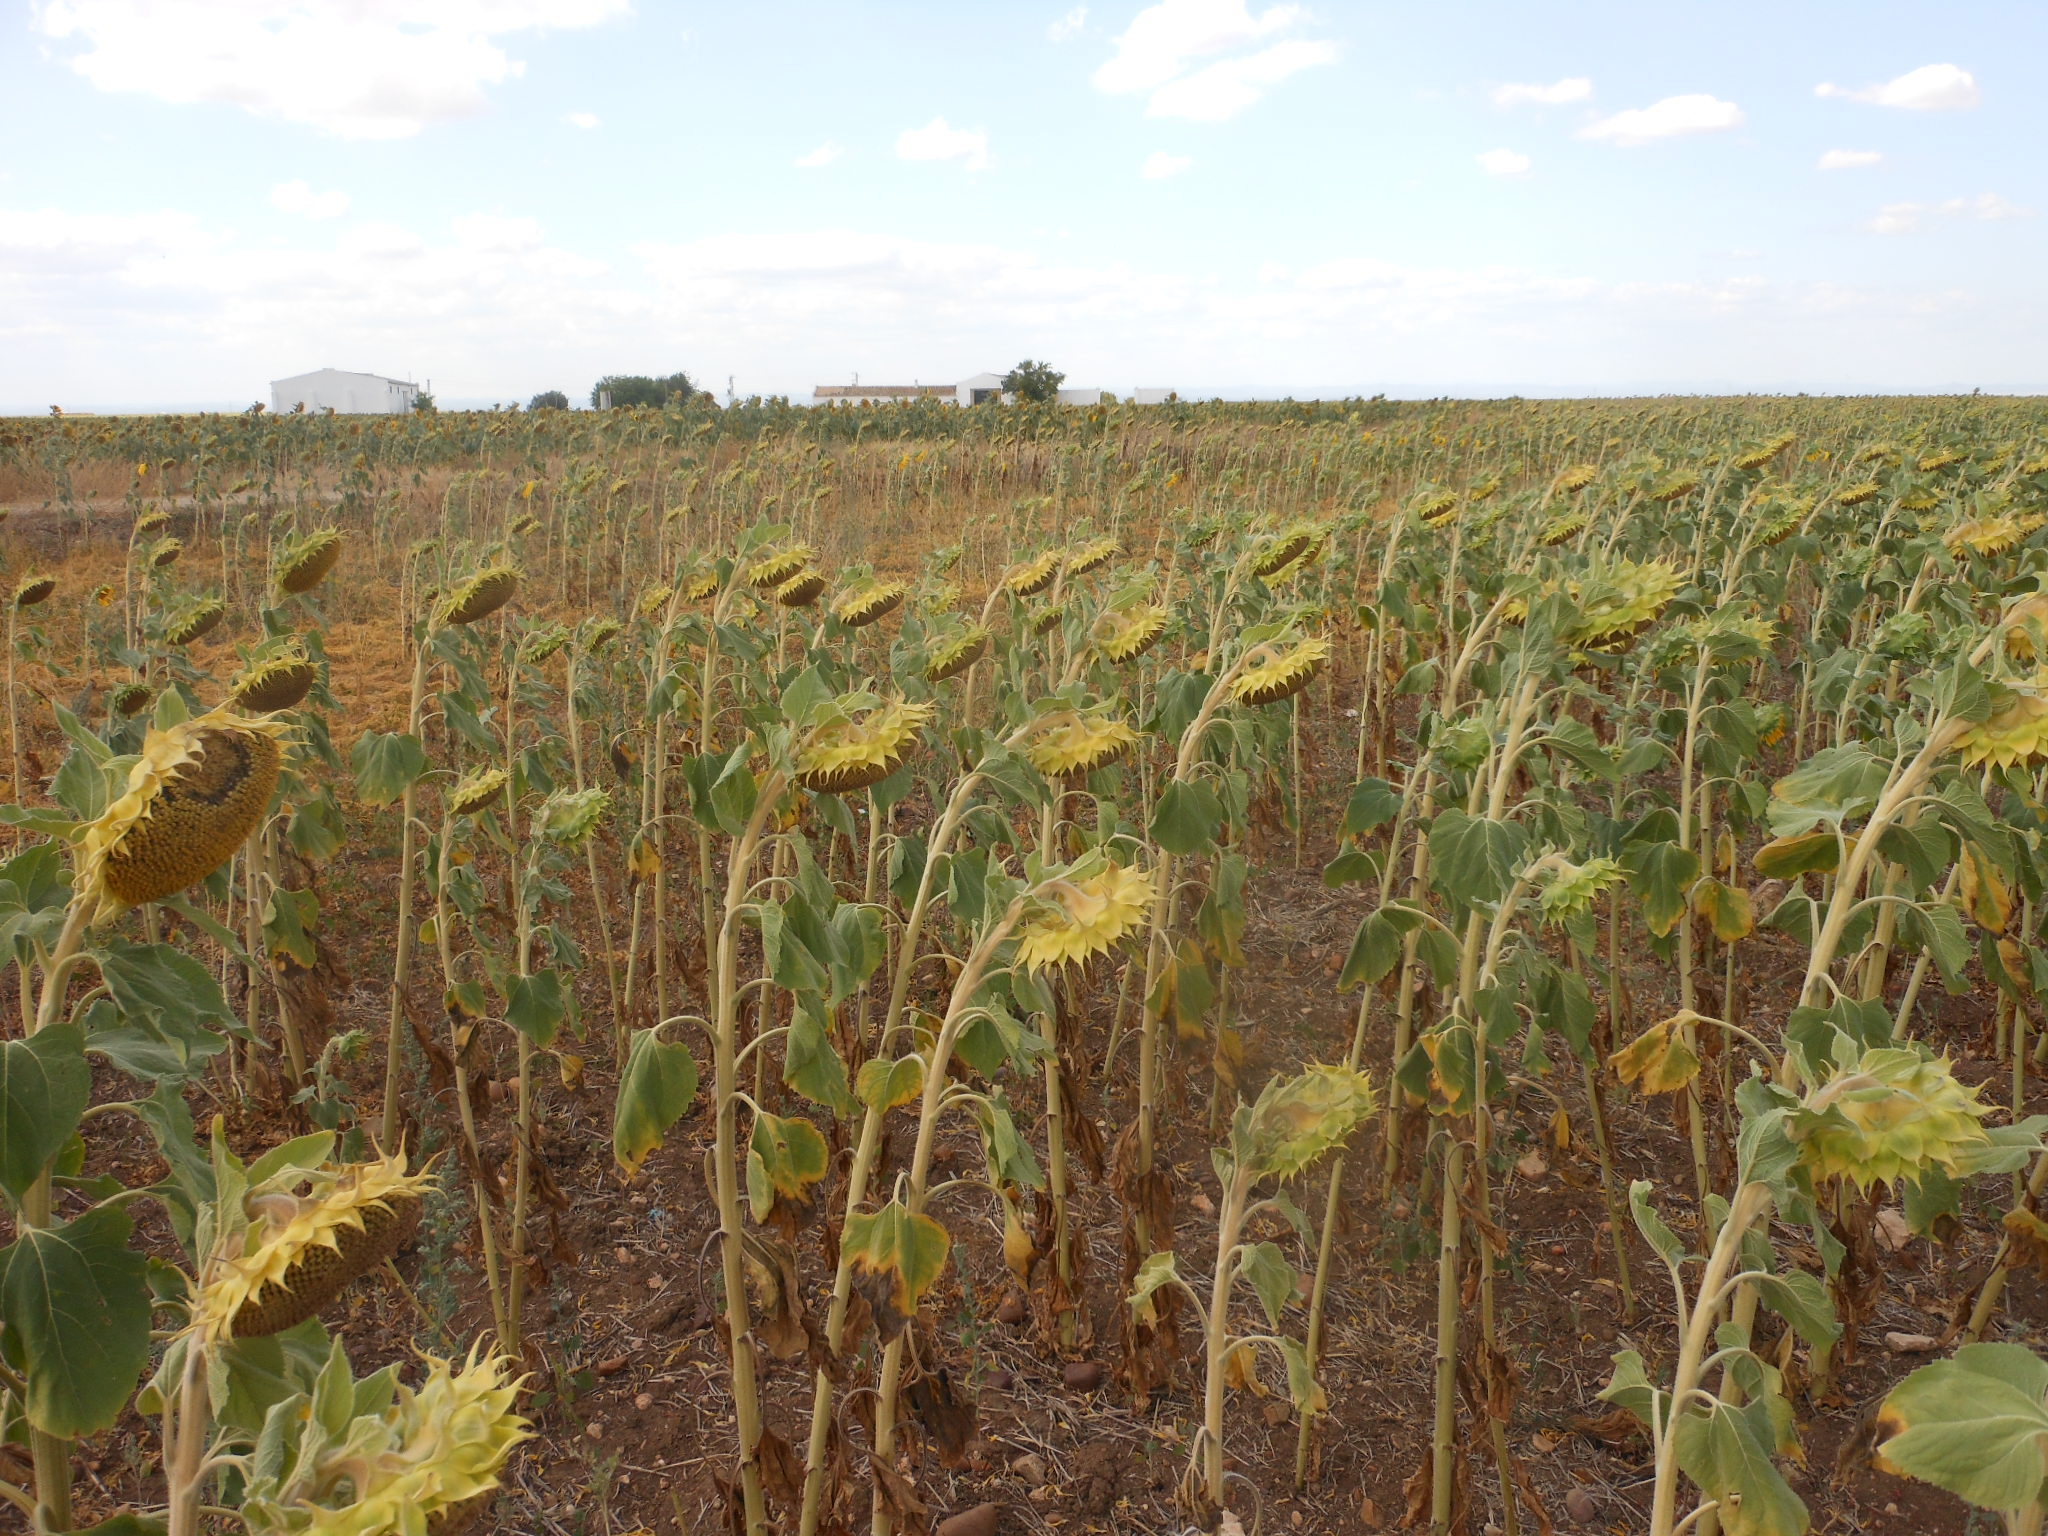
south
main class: Cropland
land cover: Sunflower
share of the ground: > 75 %
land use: Agriculture (excluding fallow land and kitchen gardens)
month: June
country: ES
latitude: 37.5785
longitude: -5.1307
